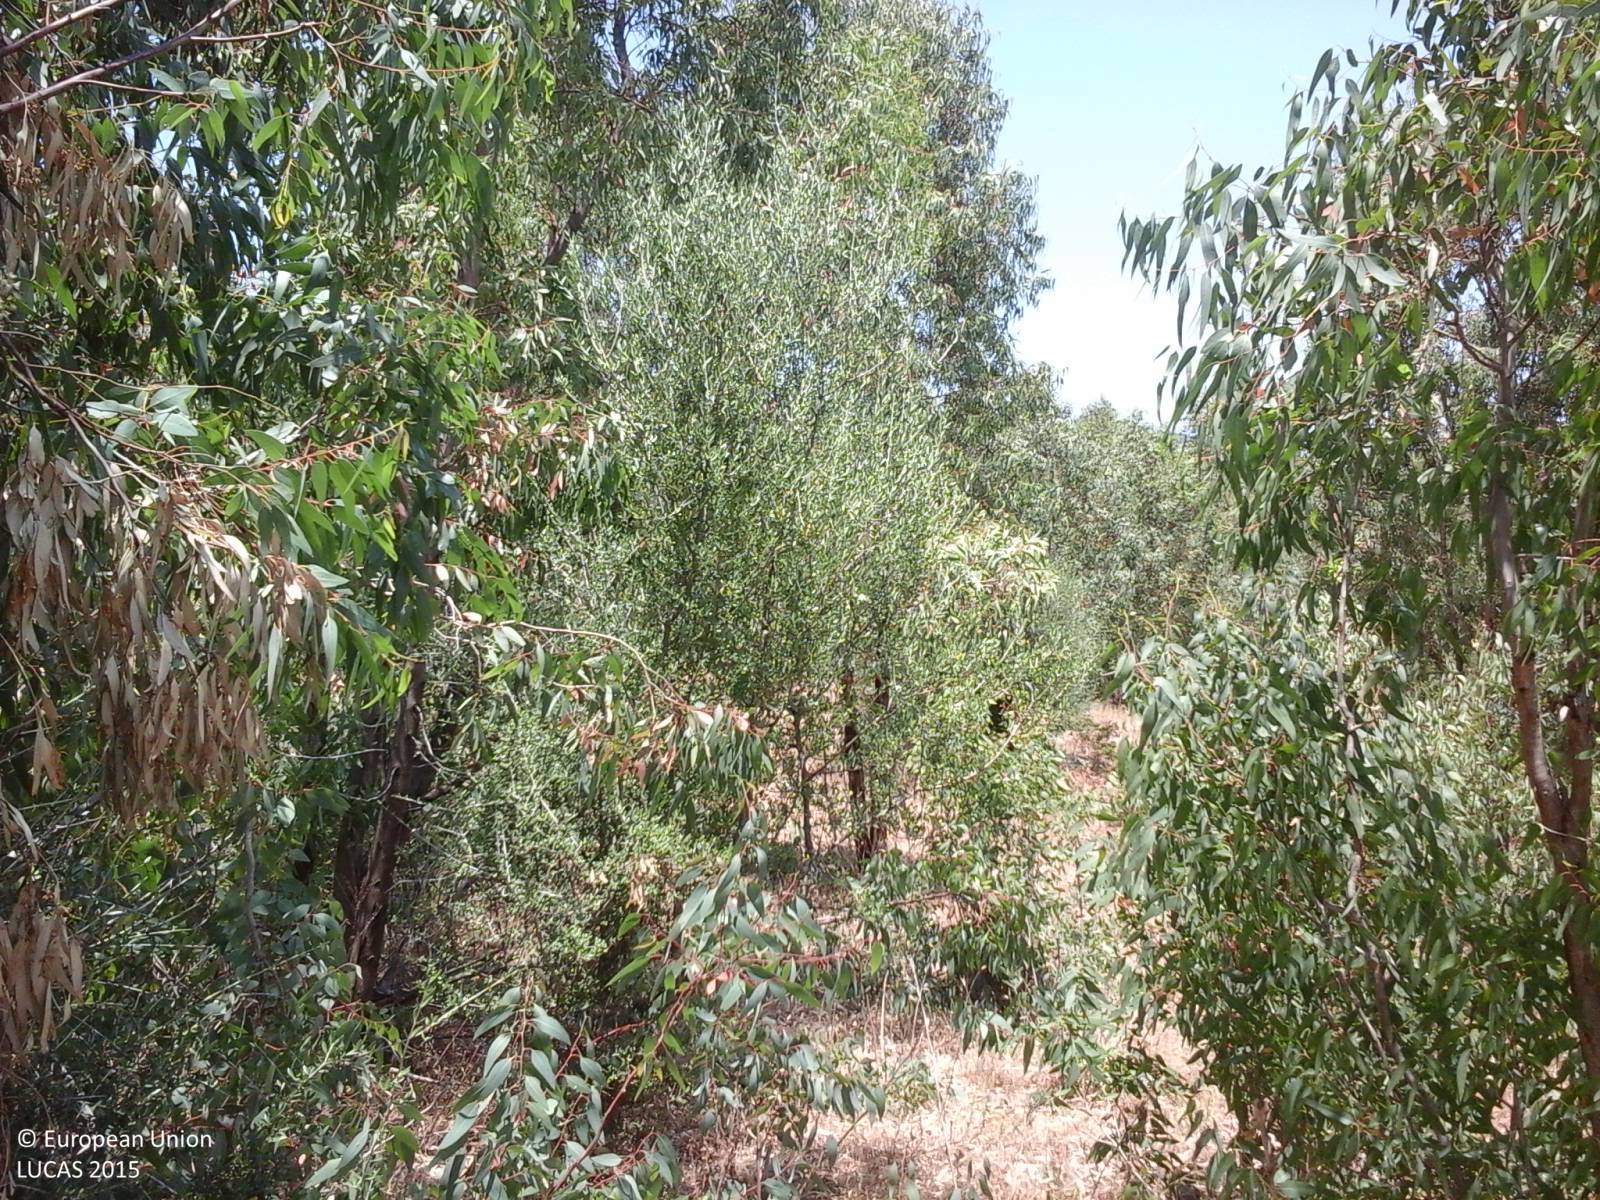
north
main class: Woodland
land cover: Broadleaved woodland
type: broadleaved evergreen forest
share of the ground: > 75 %
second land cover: Grassland without tree/shrub cover
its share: > 75 %
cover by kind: broadleaved forest trees 95 %, herbaceous plants 5 %
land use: Forestry
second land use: Agriculture (excluding fallow land and kitchen gardens)
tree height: > 5 m
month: June
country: IT
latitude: 40.4477
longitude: 9.6364
